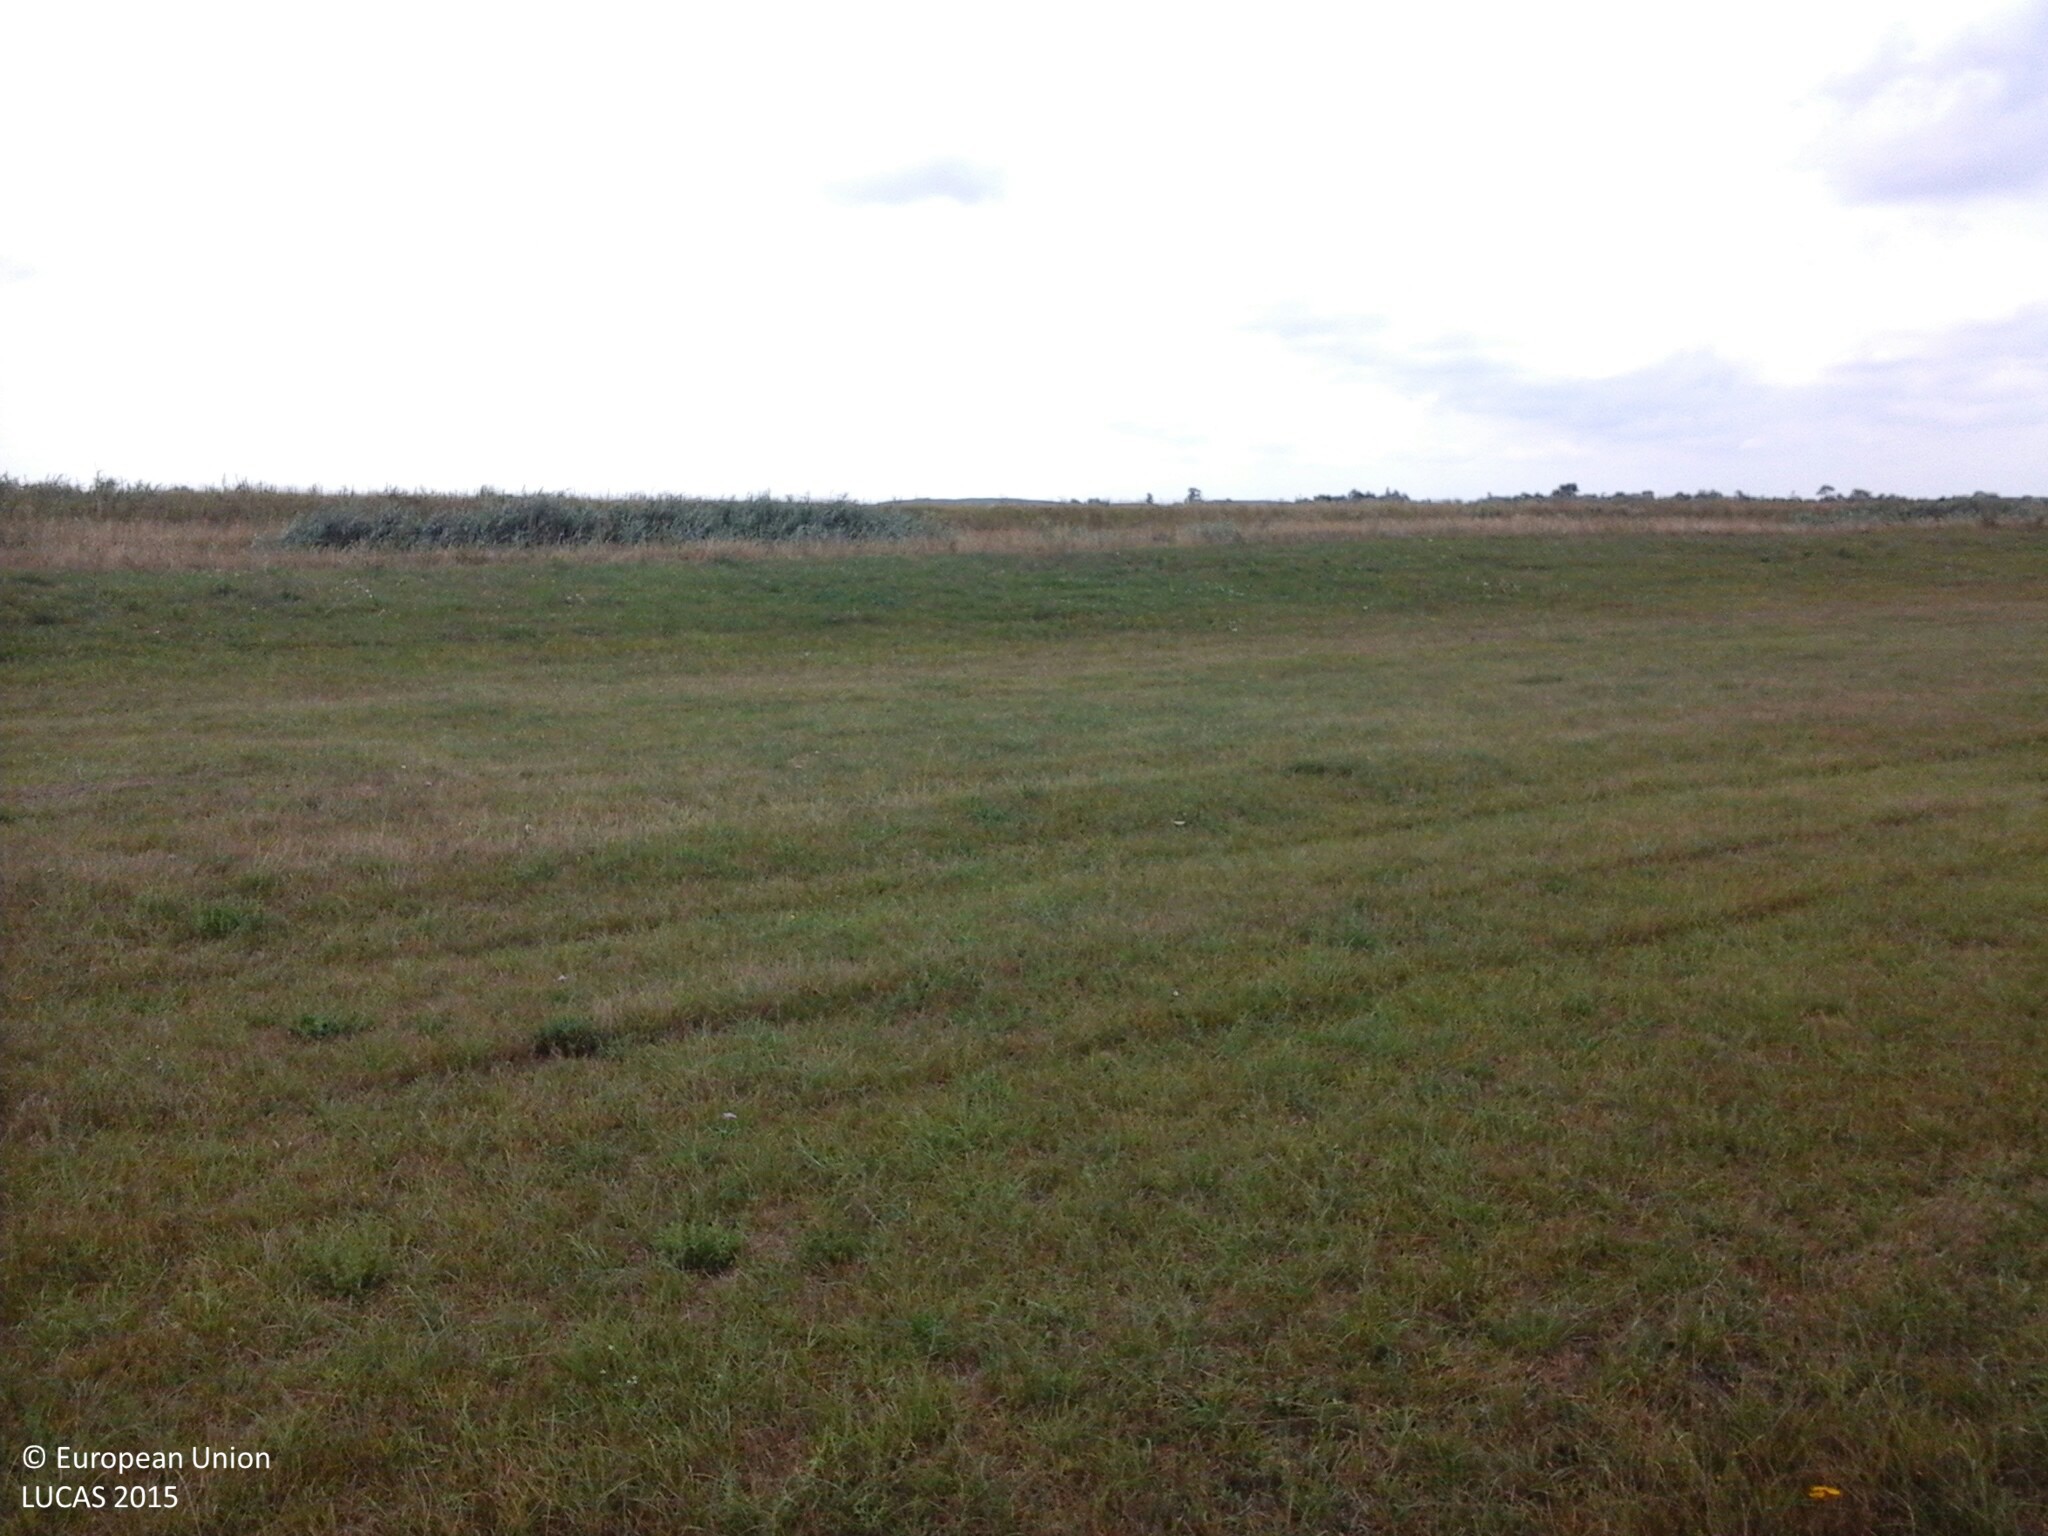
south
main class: Grassland
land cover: Grassland without tree/shrub cover
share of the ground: > 75 %
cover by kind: herbaceous plants 100 %
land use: Agriculture (excluding fallow land and kitchen gardens)
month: July
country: HU
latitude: 47.0063
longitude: 18.5221
